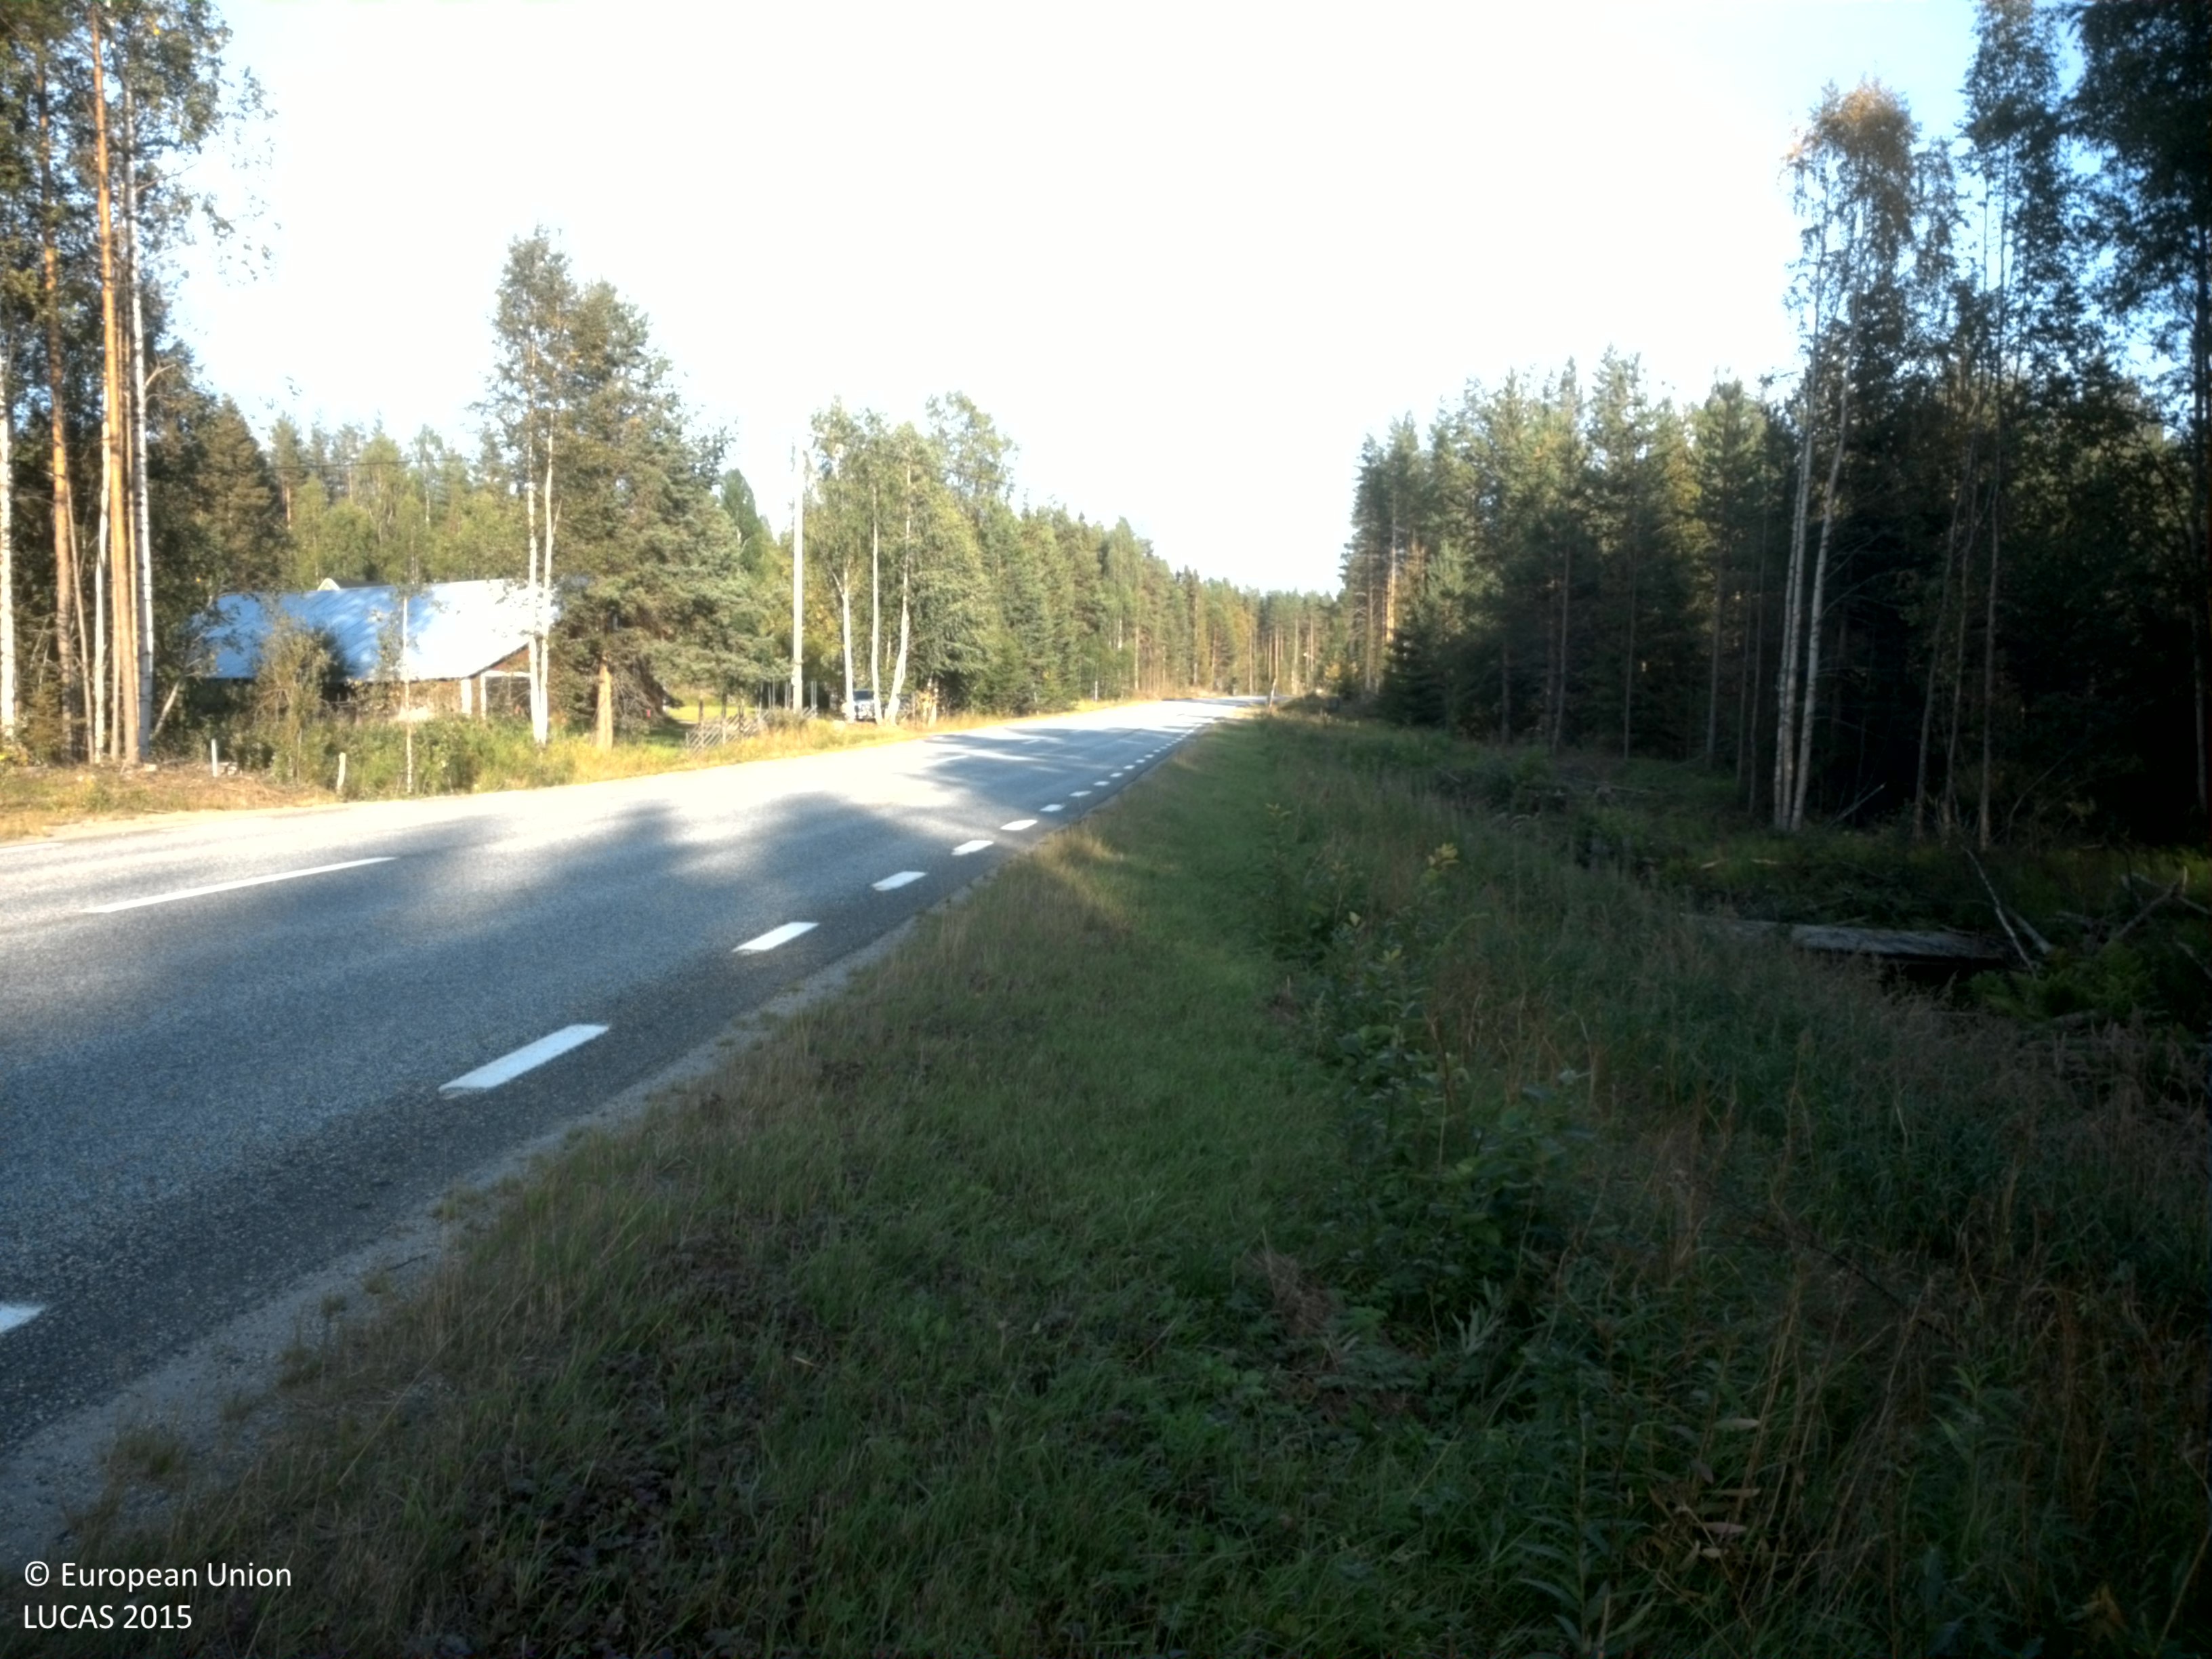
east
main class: Grassland
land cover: Grassland without tree/shrub cover
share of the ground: > 75 %
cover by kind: herbaceous plants 100 %
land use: Road transport
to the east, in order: Grassland without tree/shrub cover; Paved roads, cycling and walking lanes; Ditches and canals; Artificial constructions in urban areas; Grassland without tree/shrub cover; Pine dominated mixed woodland; Pine dominated coniferous woodland
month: August
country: SE
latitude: 64.5139
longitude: 18.8632
